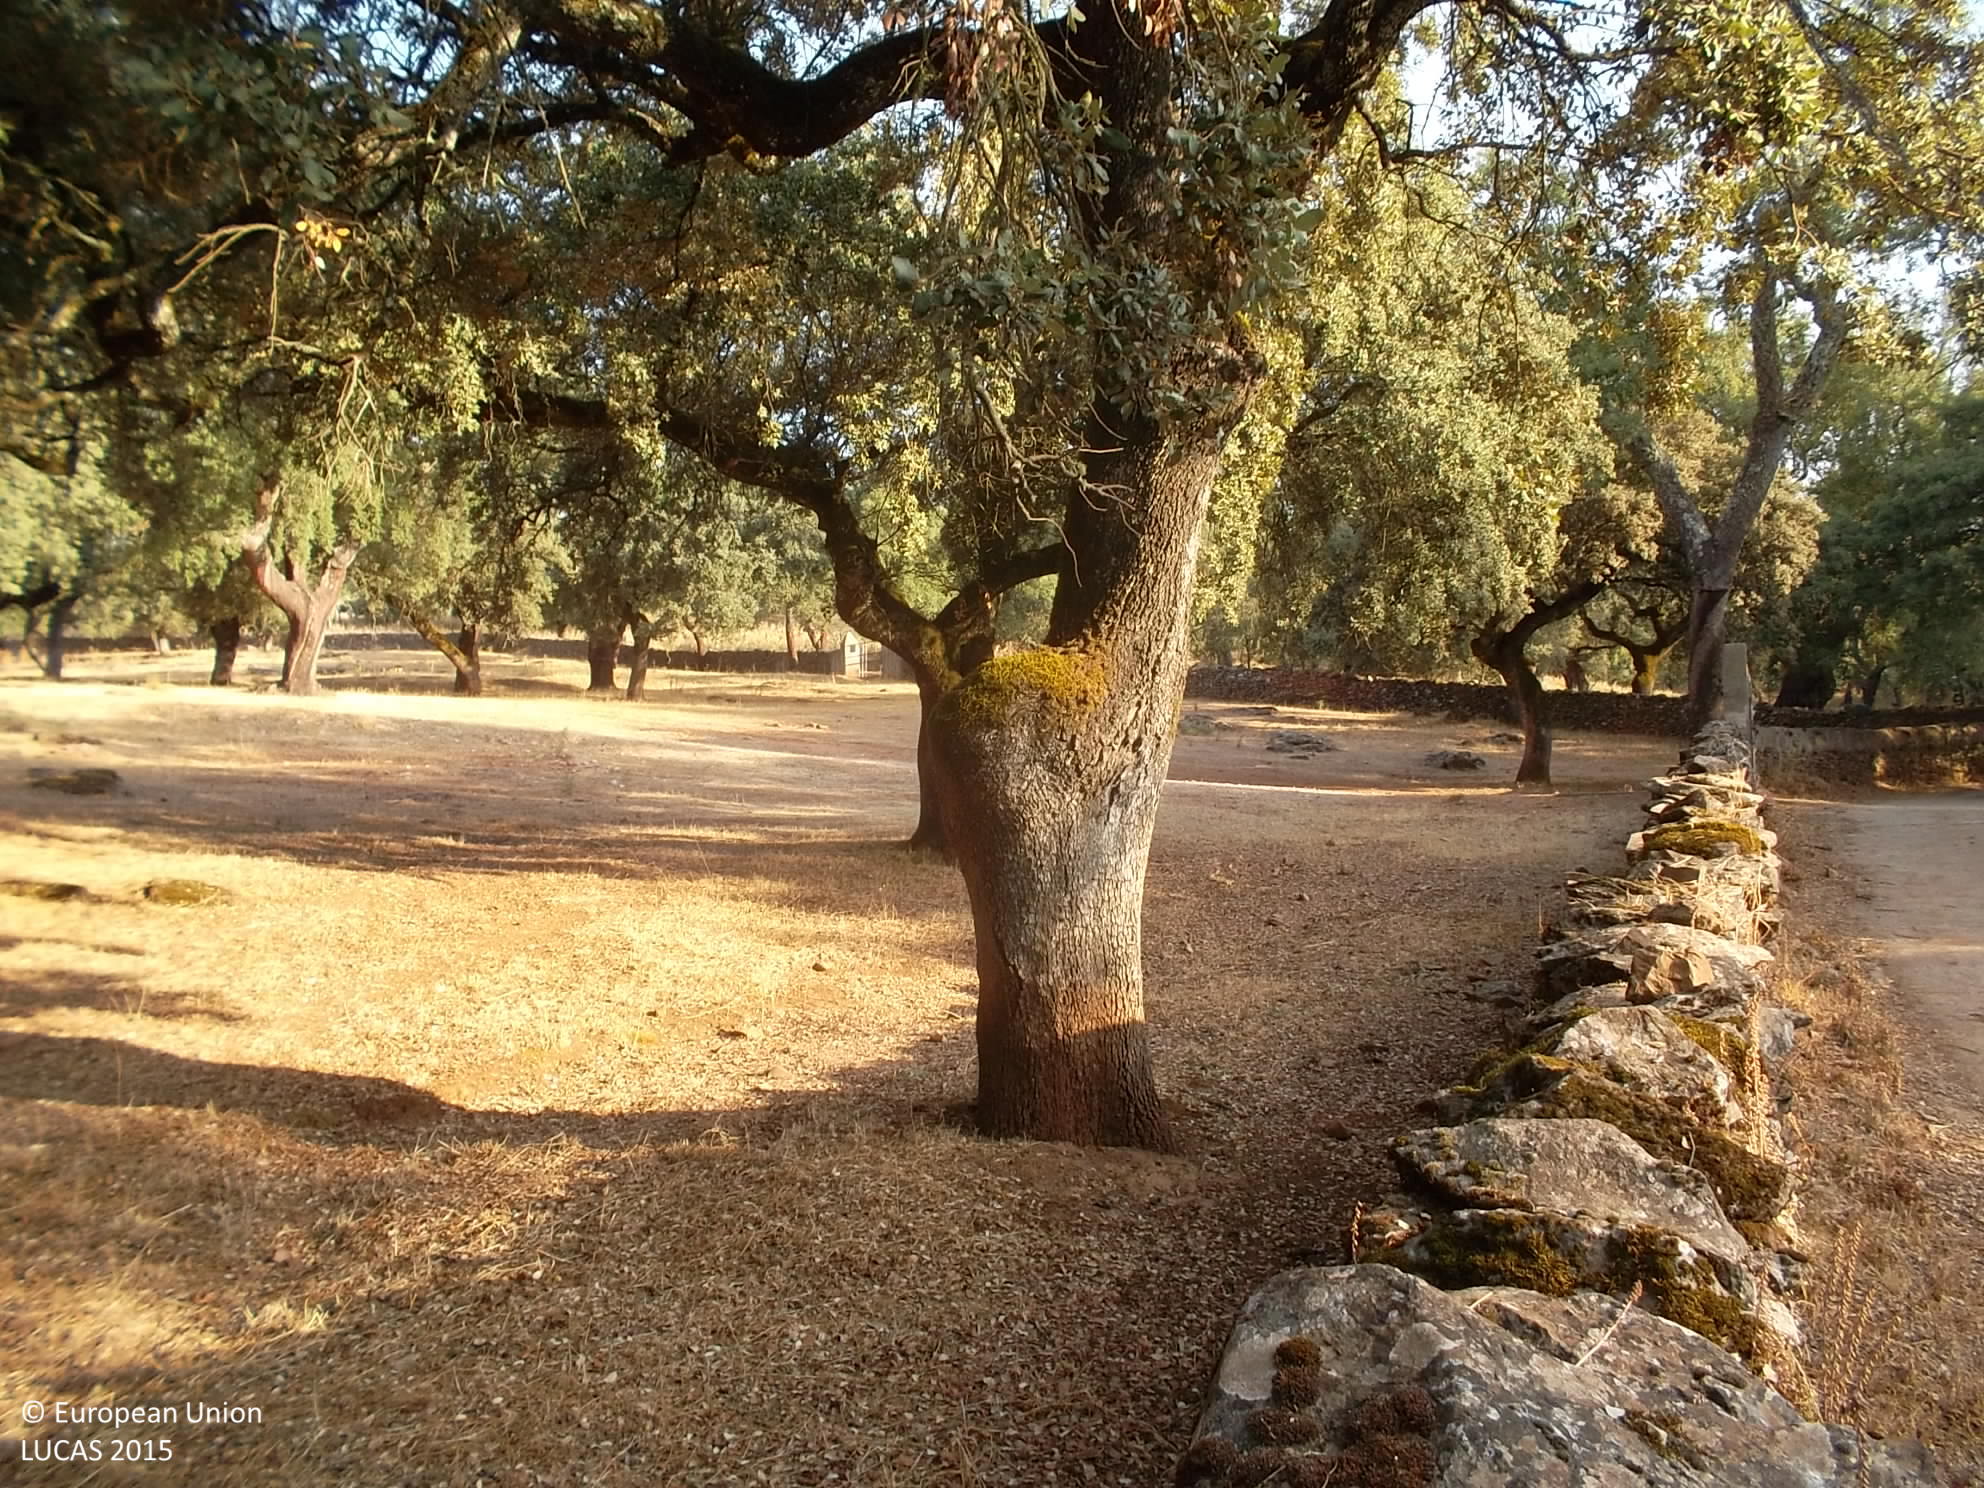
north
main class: Woodland
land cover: Broadleaved woodland
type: broadleaved evergreen forest
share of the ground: 50 - 75 %
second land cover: Grassland without tree/shrub cover
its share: > 75 %
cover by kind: broadleaved forest trees 60 %, herbaceous plants 40 %
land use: Forestry
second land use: Agriculture (excluding fallow land and kitchen gardens)
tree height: > 5 m
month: September
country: ES
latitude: 38.0347
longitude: -6.5780
